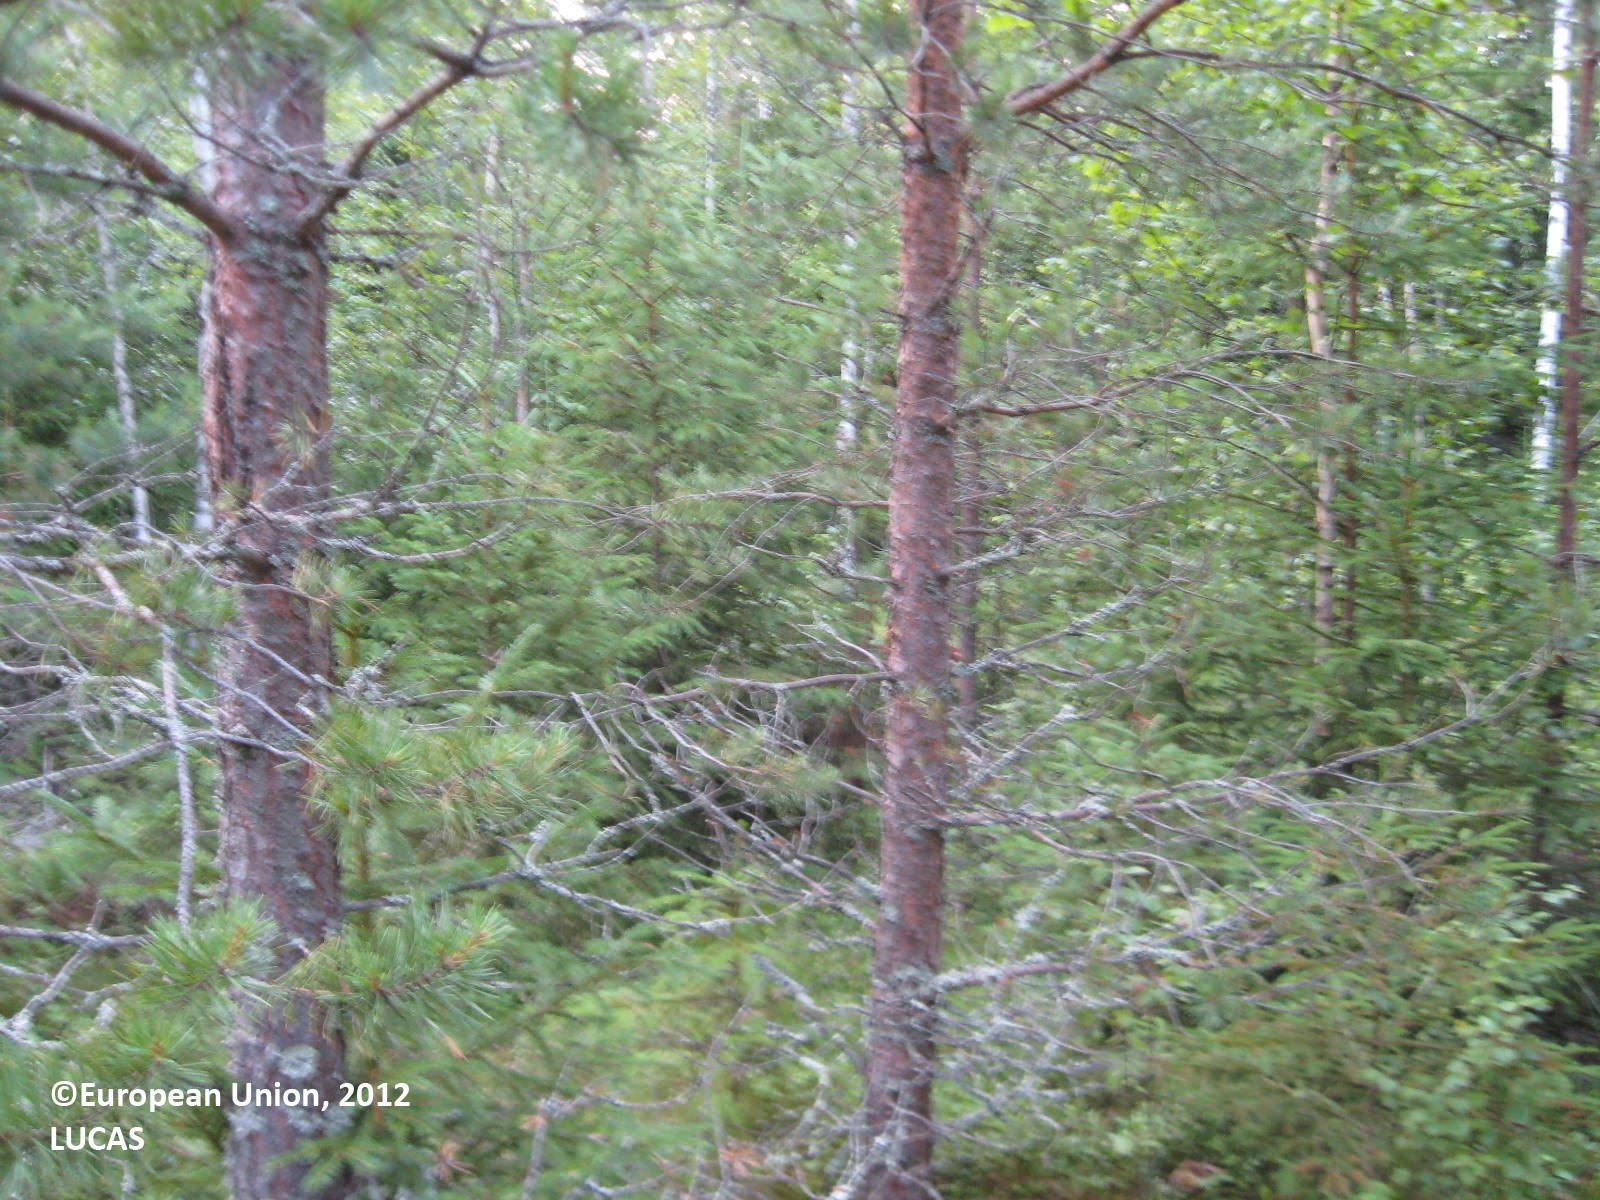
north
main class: Woodland
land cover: Other mixed woodland
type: boreal forest
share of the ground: > 75 %
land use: Forestry
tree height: > 5 m
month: July
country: FI
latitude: 62.3439
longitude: 21.3792
